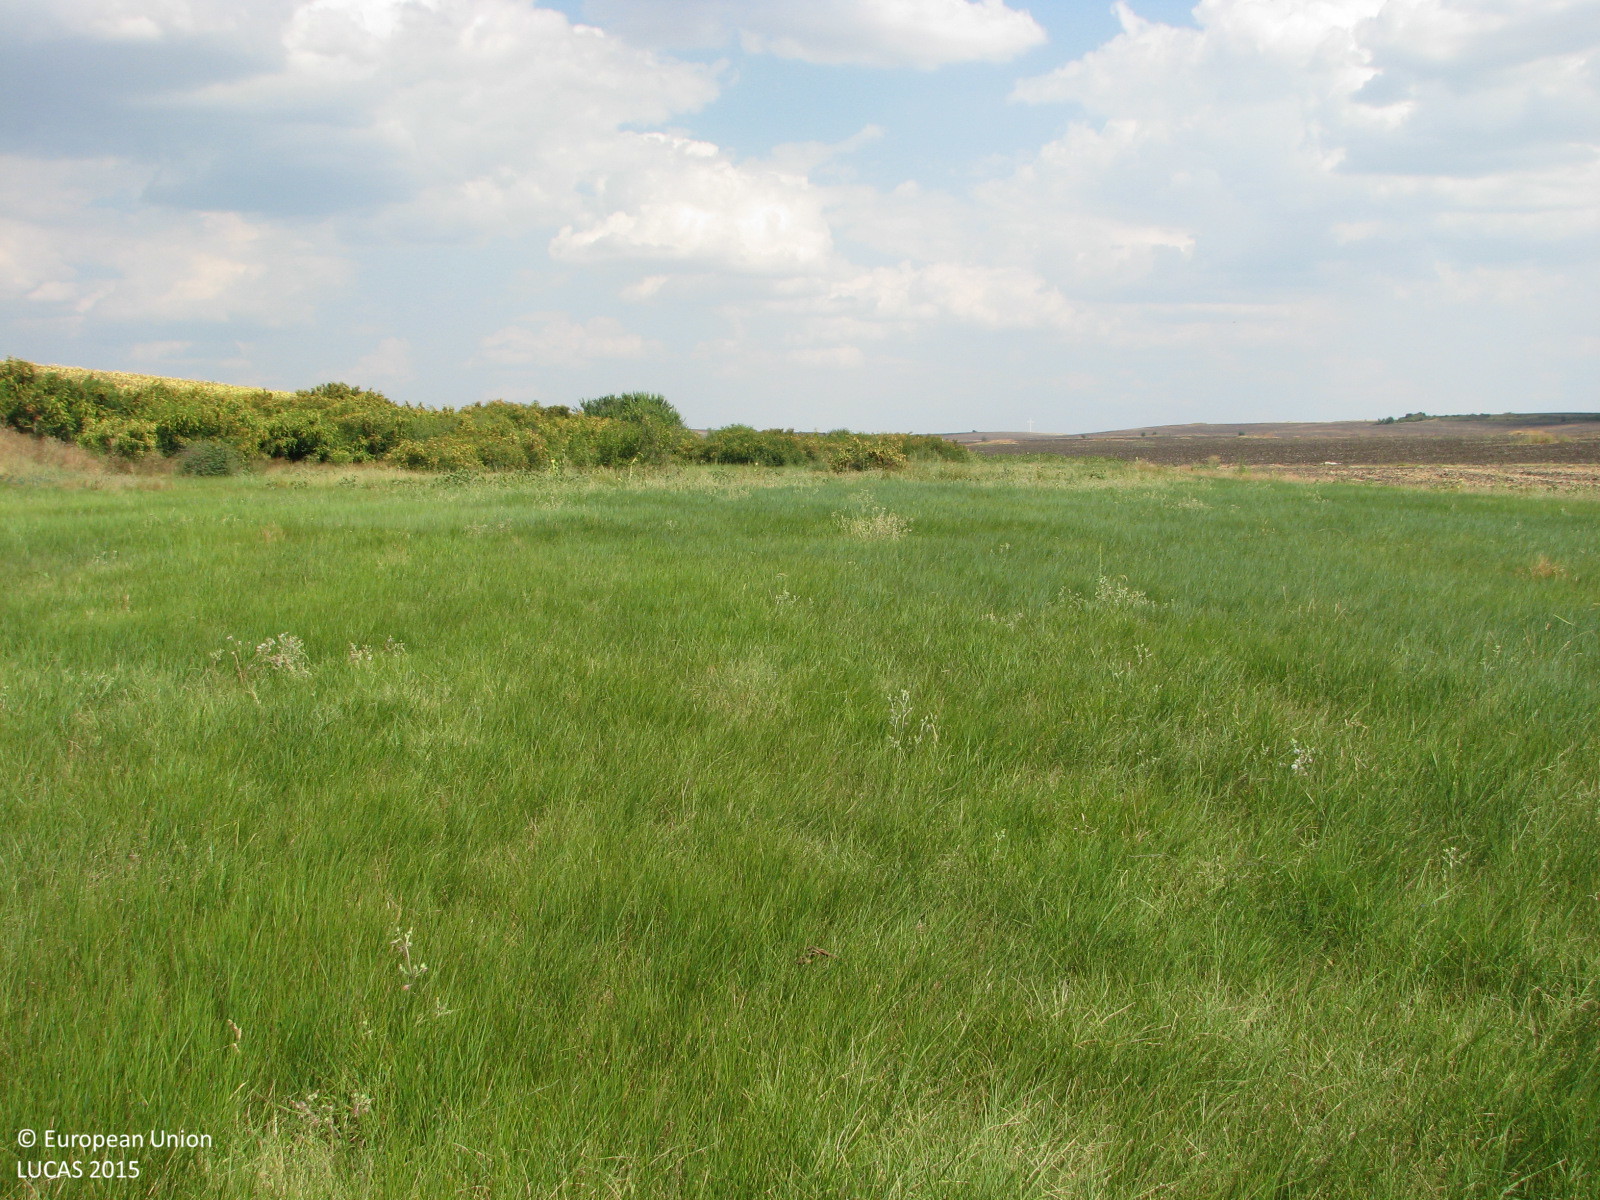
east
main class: Grassland
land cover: Grassland without tree/shrub cover
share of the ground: > 75 %
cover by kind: herbaceous plants 100 %
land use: Agriculture (excluding fallow land and kitchen gardens)
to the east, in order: Grassland without tree/shrub cover; Shrubland with sparse tree cover; Grassland with sparse tree/shrub cover; Broadleaved woodland; Grassland without tree/shrub cover
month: August
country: BG
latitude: 42.1482
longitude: 26.7568
